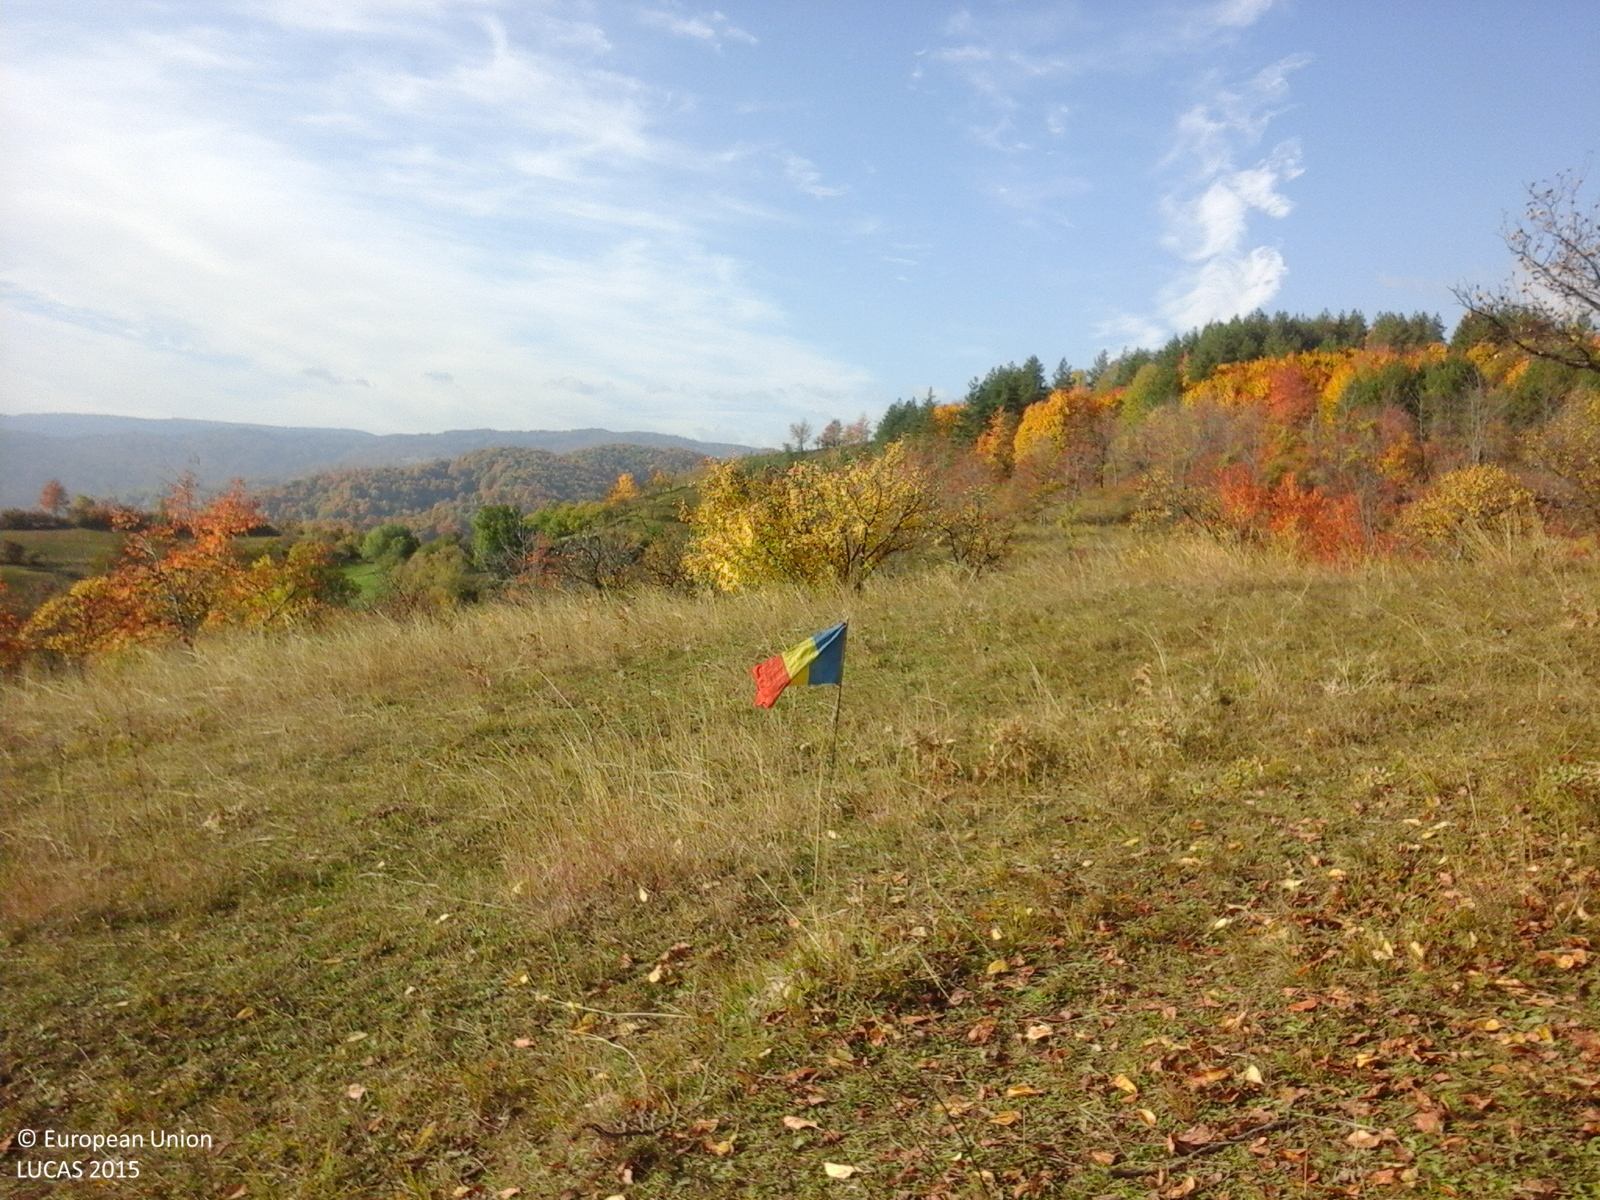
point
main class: Cropland
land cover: Other fruit trees and berries
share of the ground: > 75 %
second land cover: Grassland without tree/shrub cover
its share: > 75 %
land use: Agriculture (excluding fallow land and kitchen gardens)
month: October
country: RO
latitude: 45.8130
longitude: 26.7227
